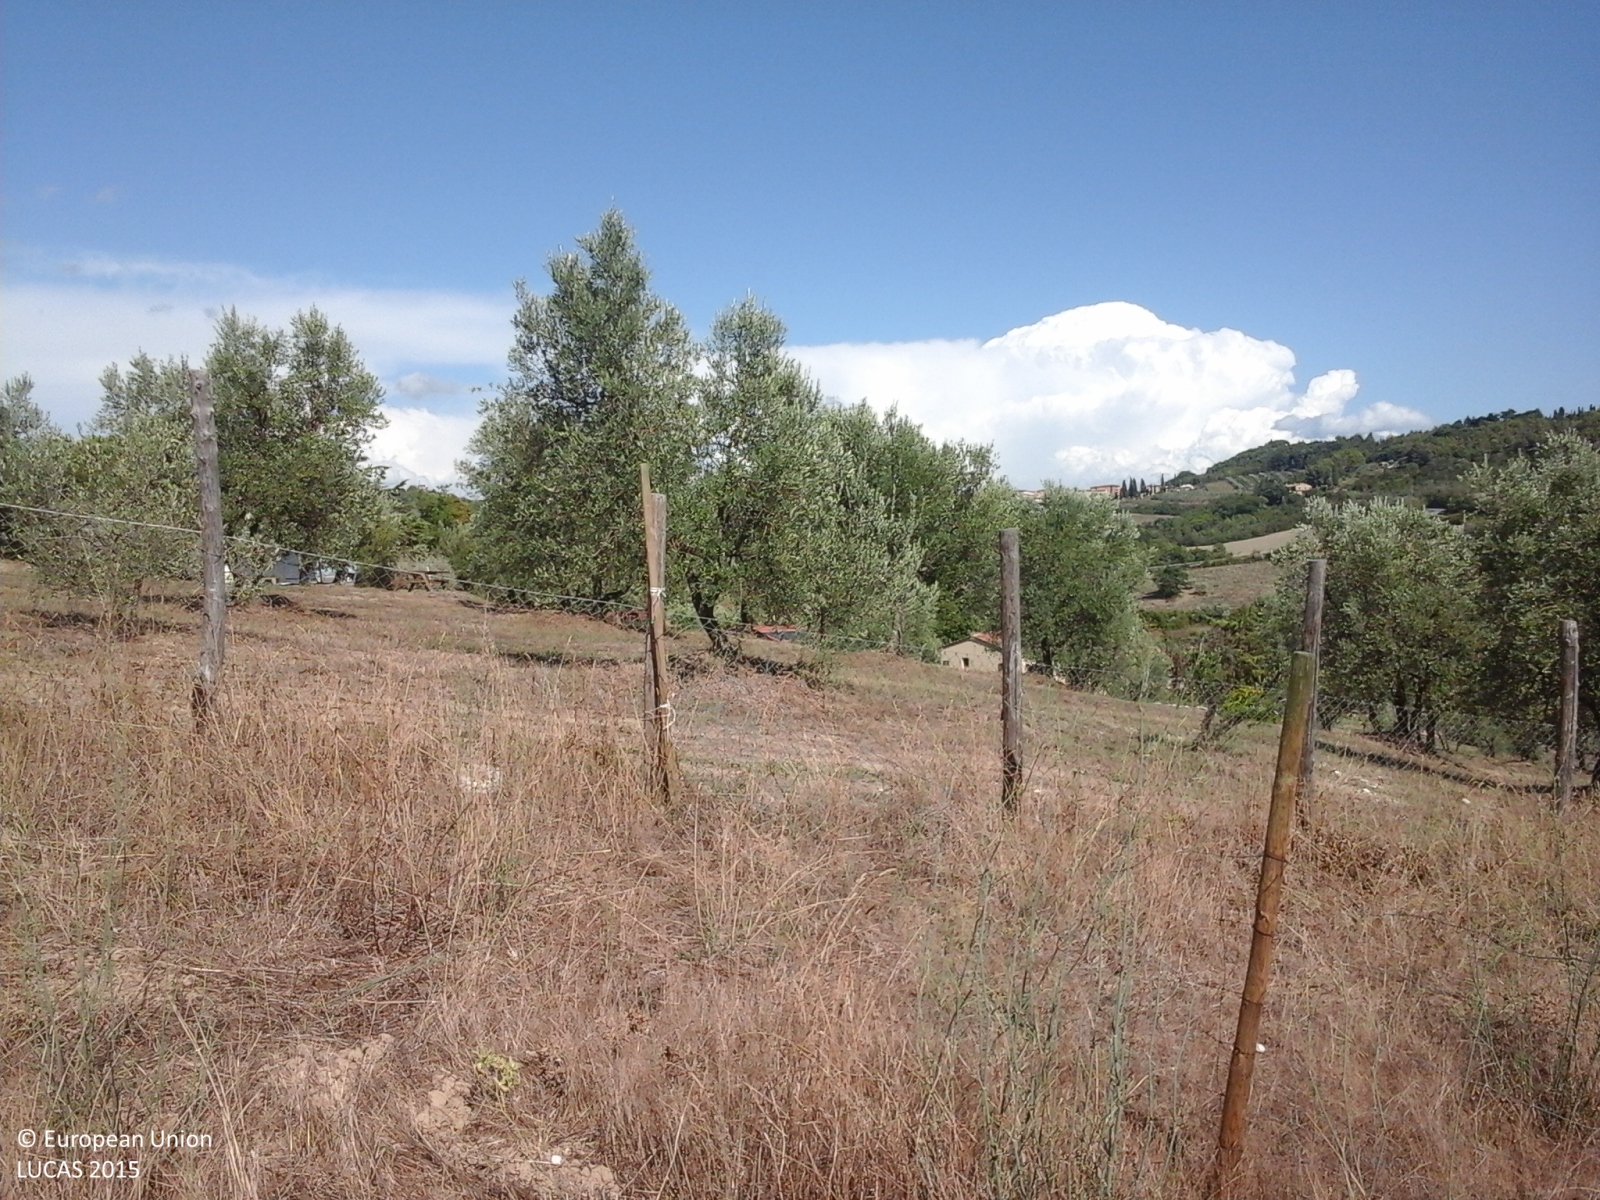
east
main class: Grassland
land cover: Grassland without tree/shrub cover
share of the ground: > 75 %
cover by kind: herbaceous plants 100 %
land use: Agriculture (excluding fallow land and kitchen gardens)
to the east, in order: Grassland without tree/shrub cover; Broadleaved woodland; Grassland without tree/shrub cover; Electric lines; Grassland without tree/shrub cover
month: August
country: IT
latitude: 43.3005
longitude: 10.8481
